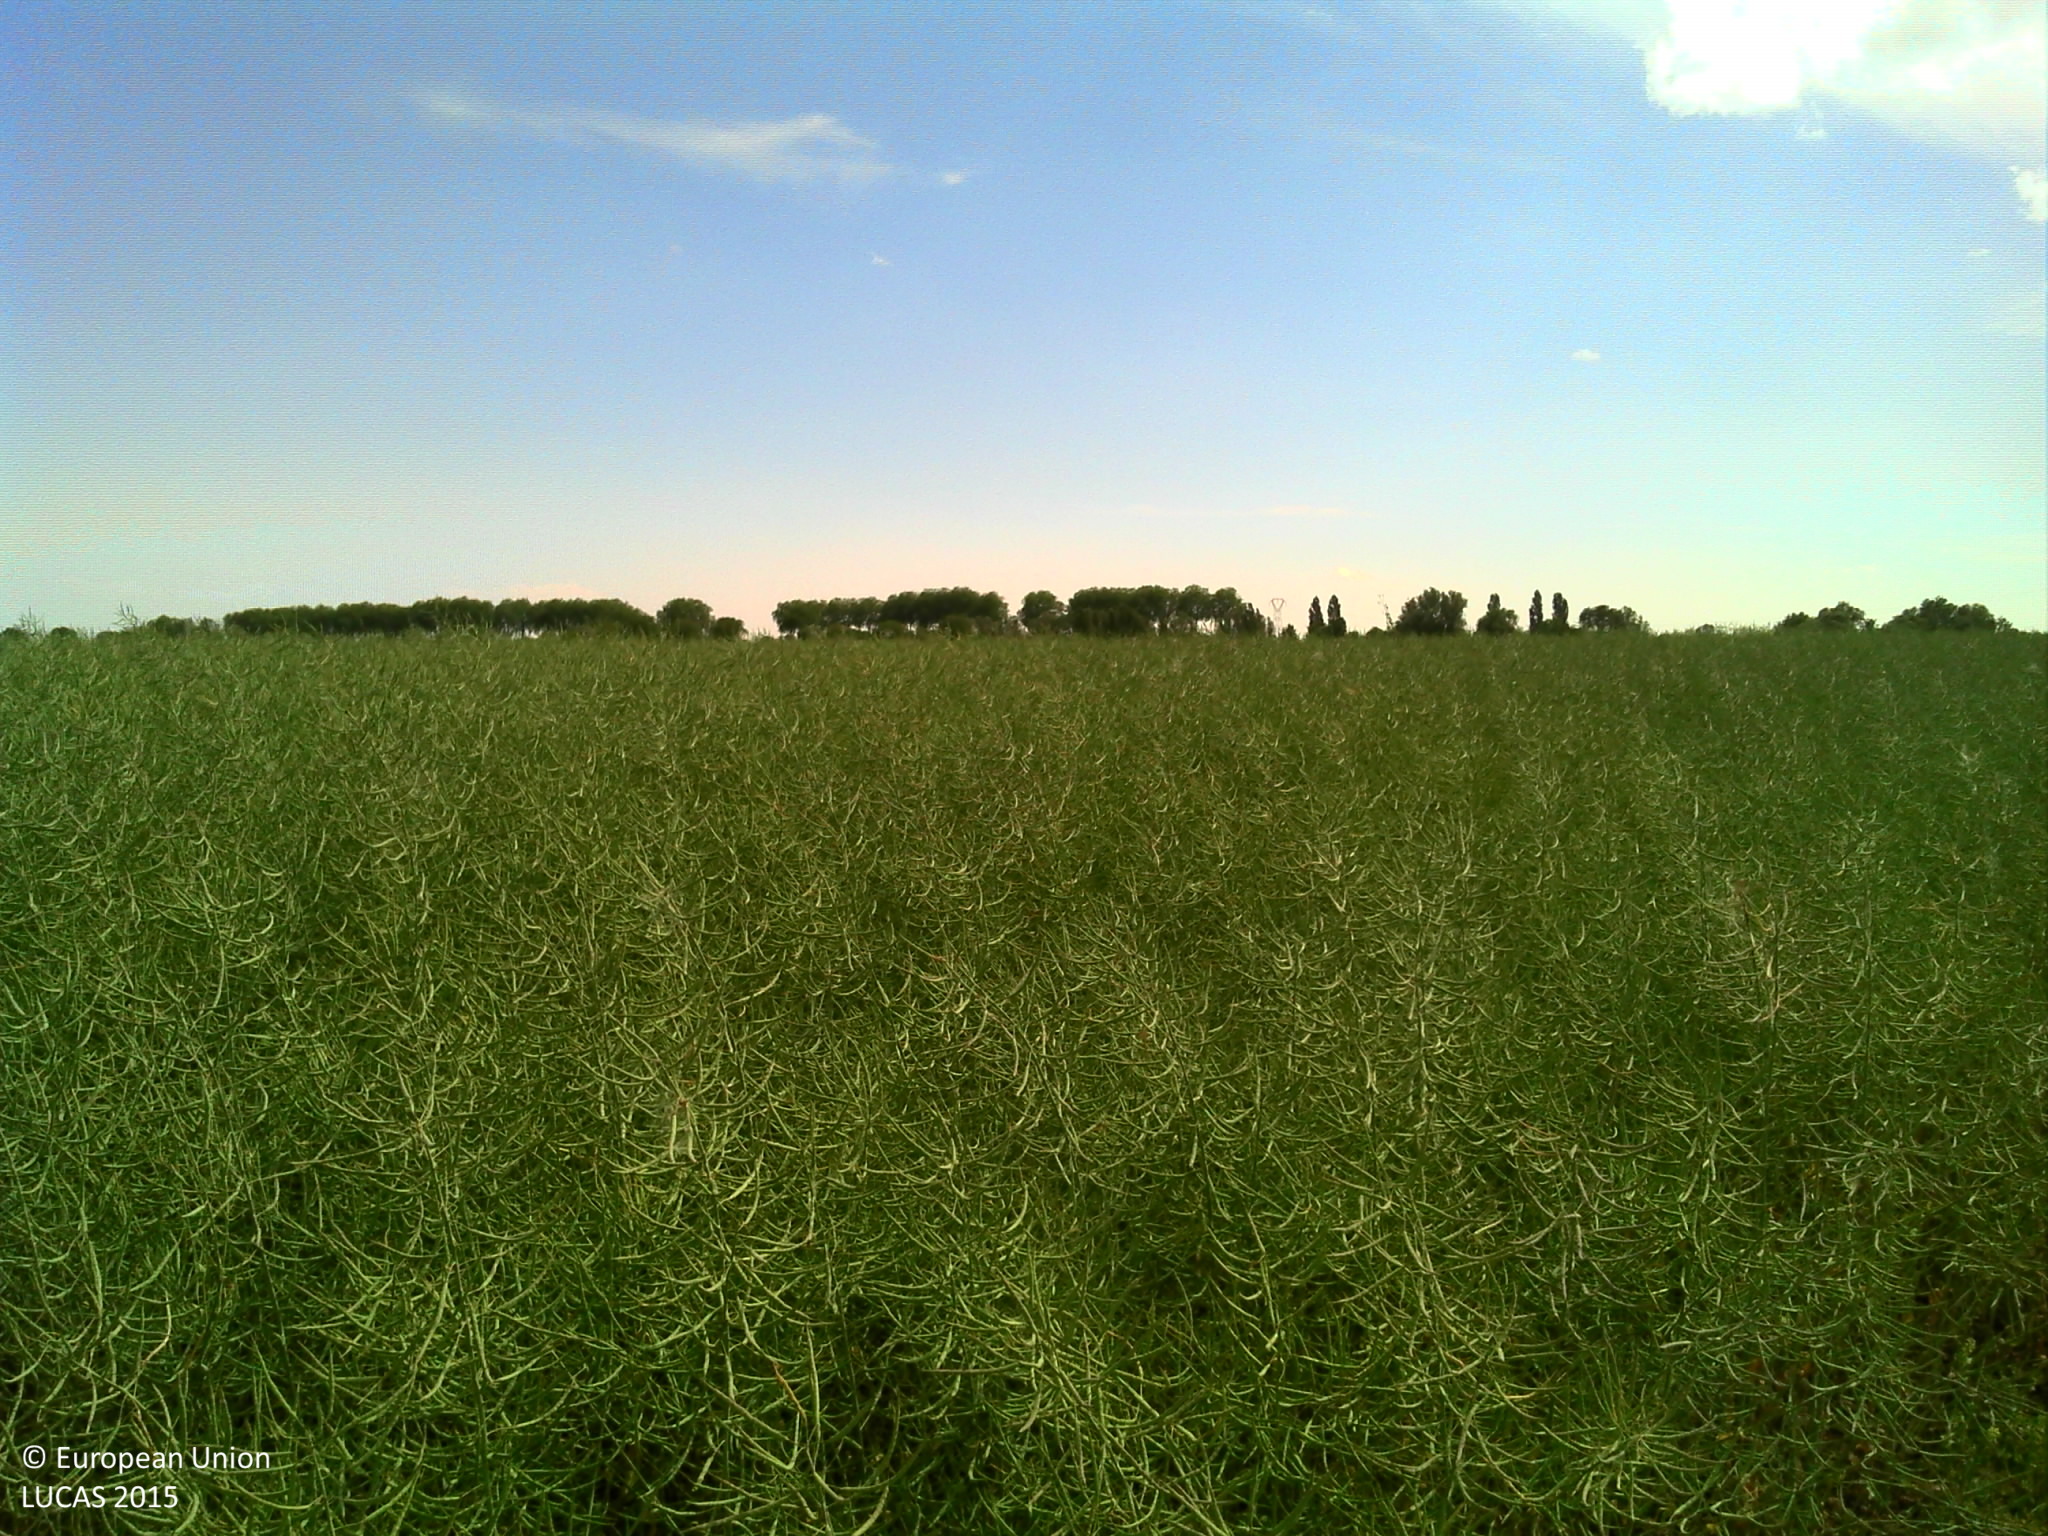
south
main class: Cropland
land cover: Rape and turnip rape
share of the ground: > 75 %
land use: Agriculture (excluding fallow land and kitchen gardens)
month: May
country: FR
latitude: 47.2538
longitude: 5.2043
